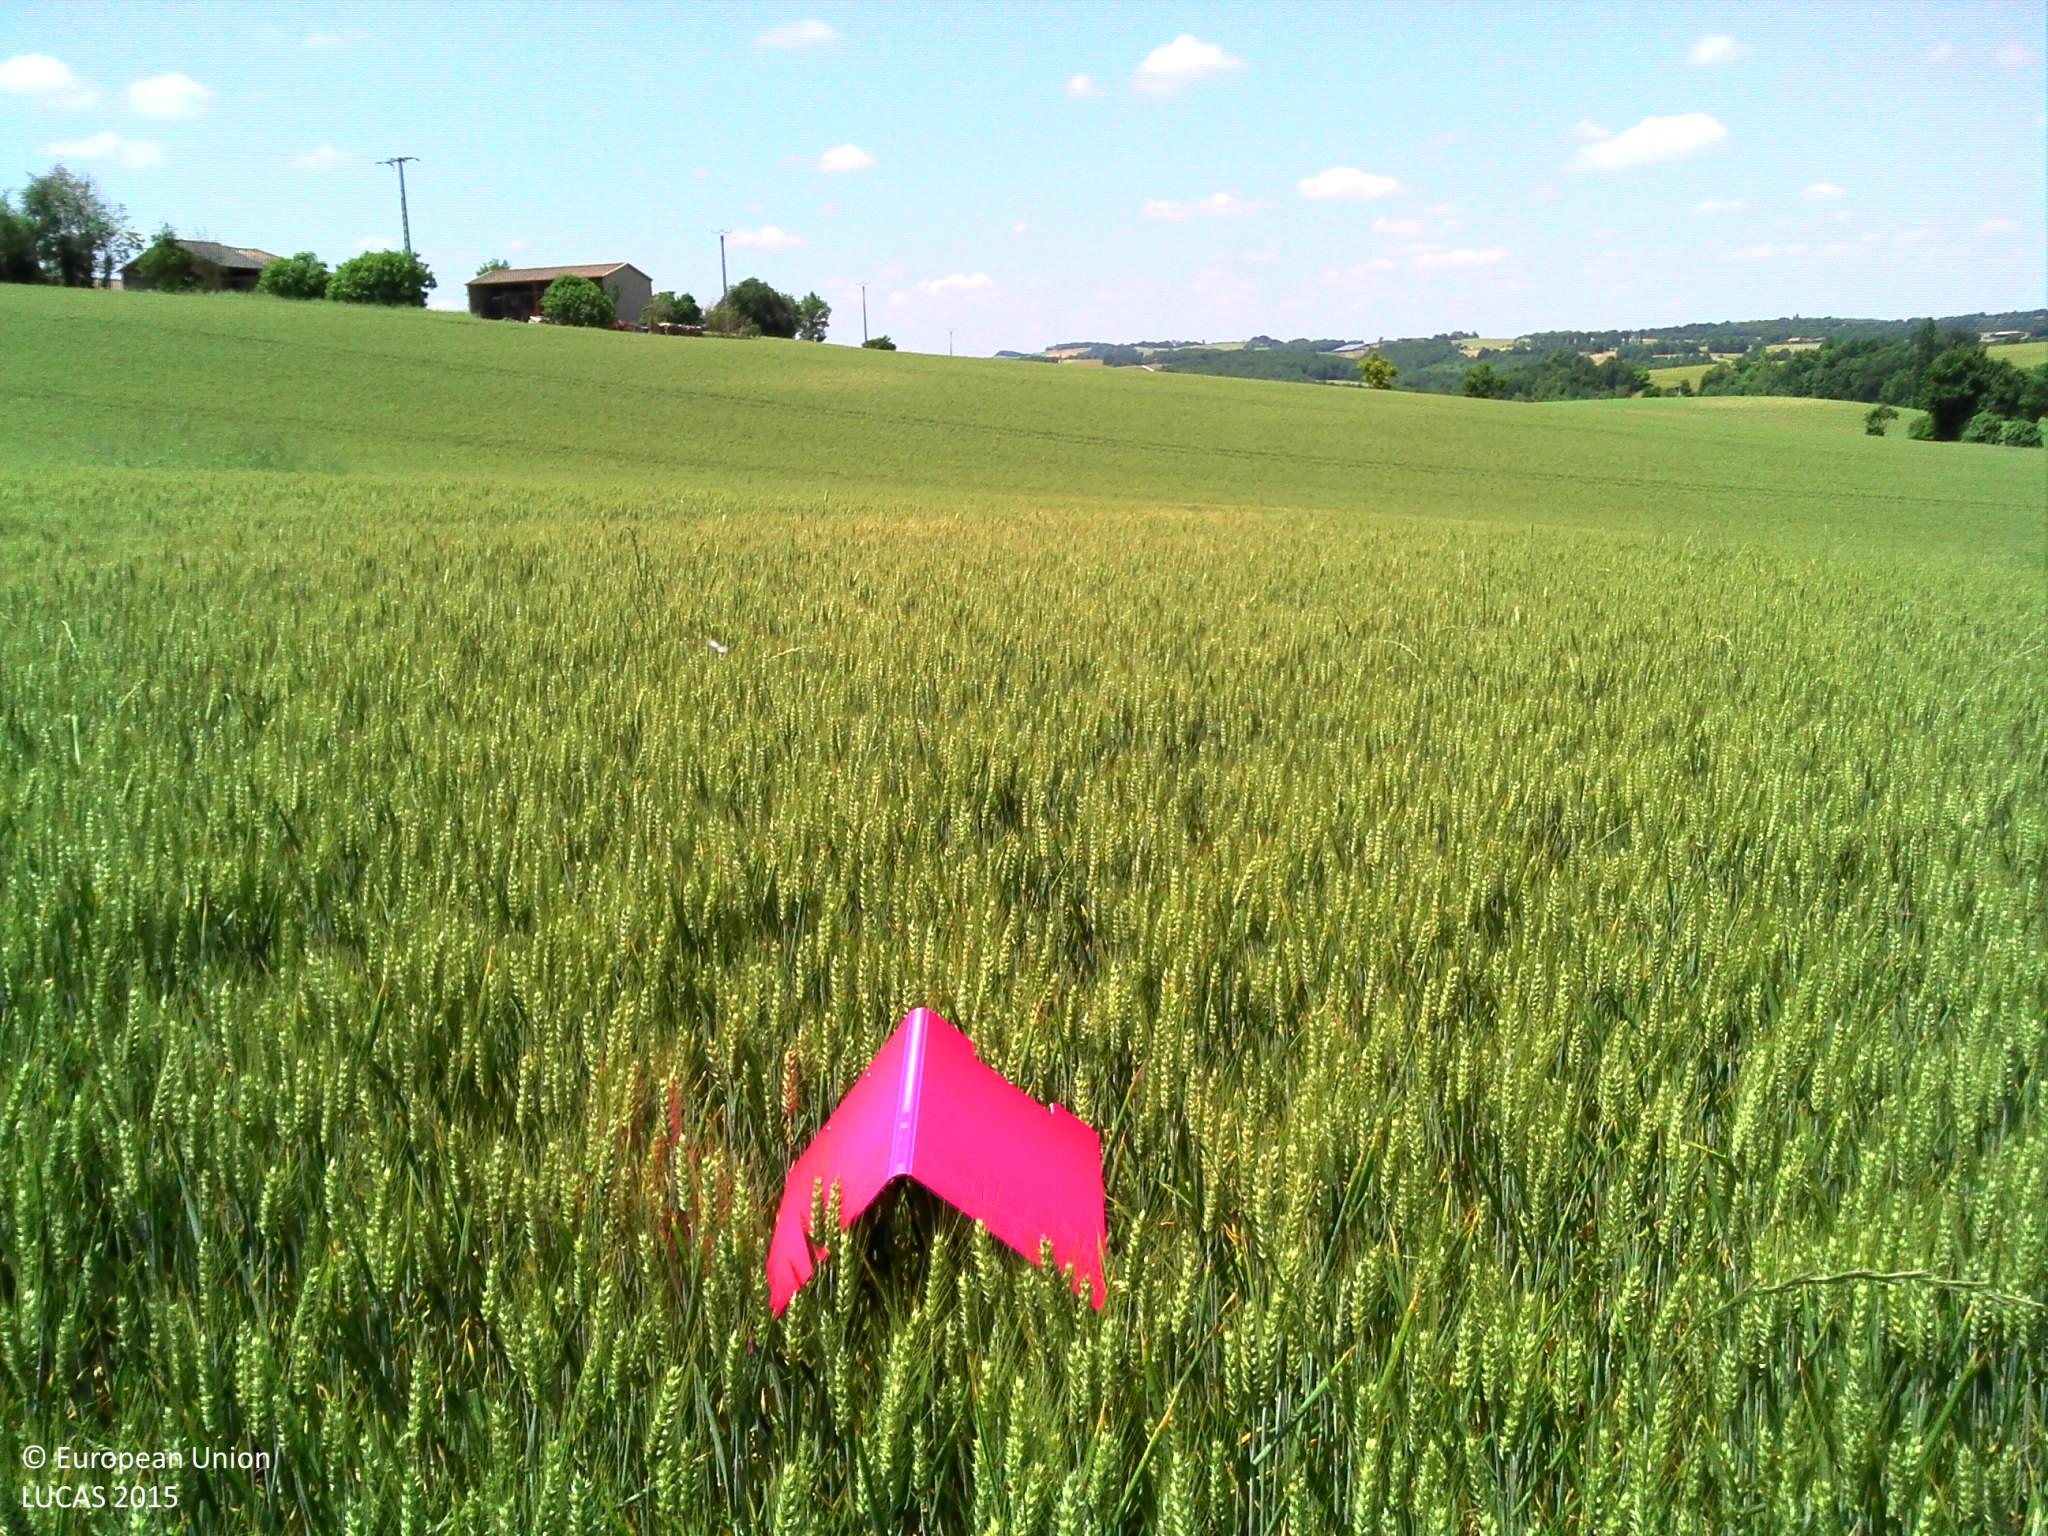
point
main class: Cropland
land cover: Common wheat
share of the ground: > 75 %
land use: Agriculture (excluding fallow land and kitchen gardens)
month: June
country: FR
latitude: 43.5937
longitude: 0.7711
